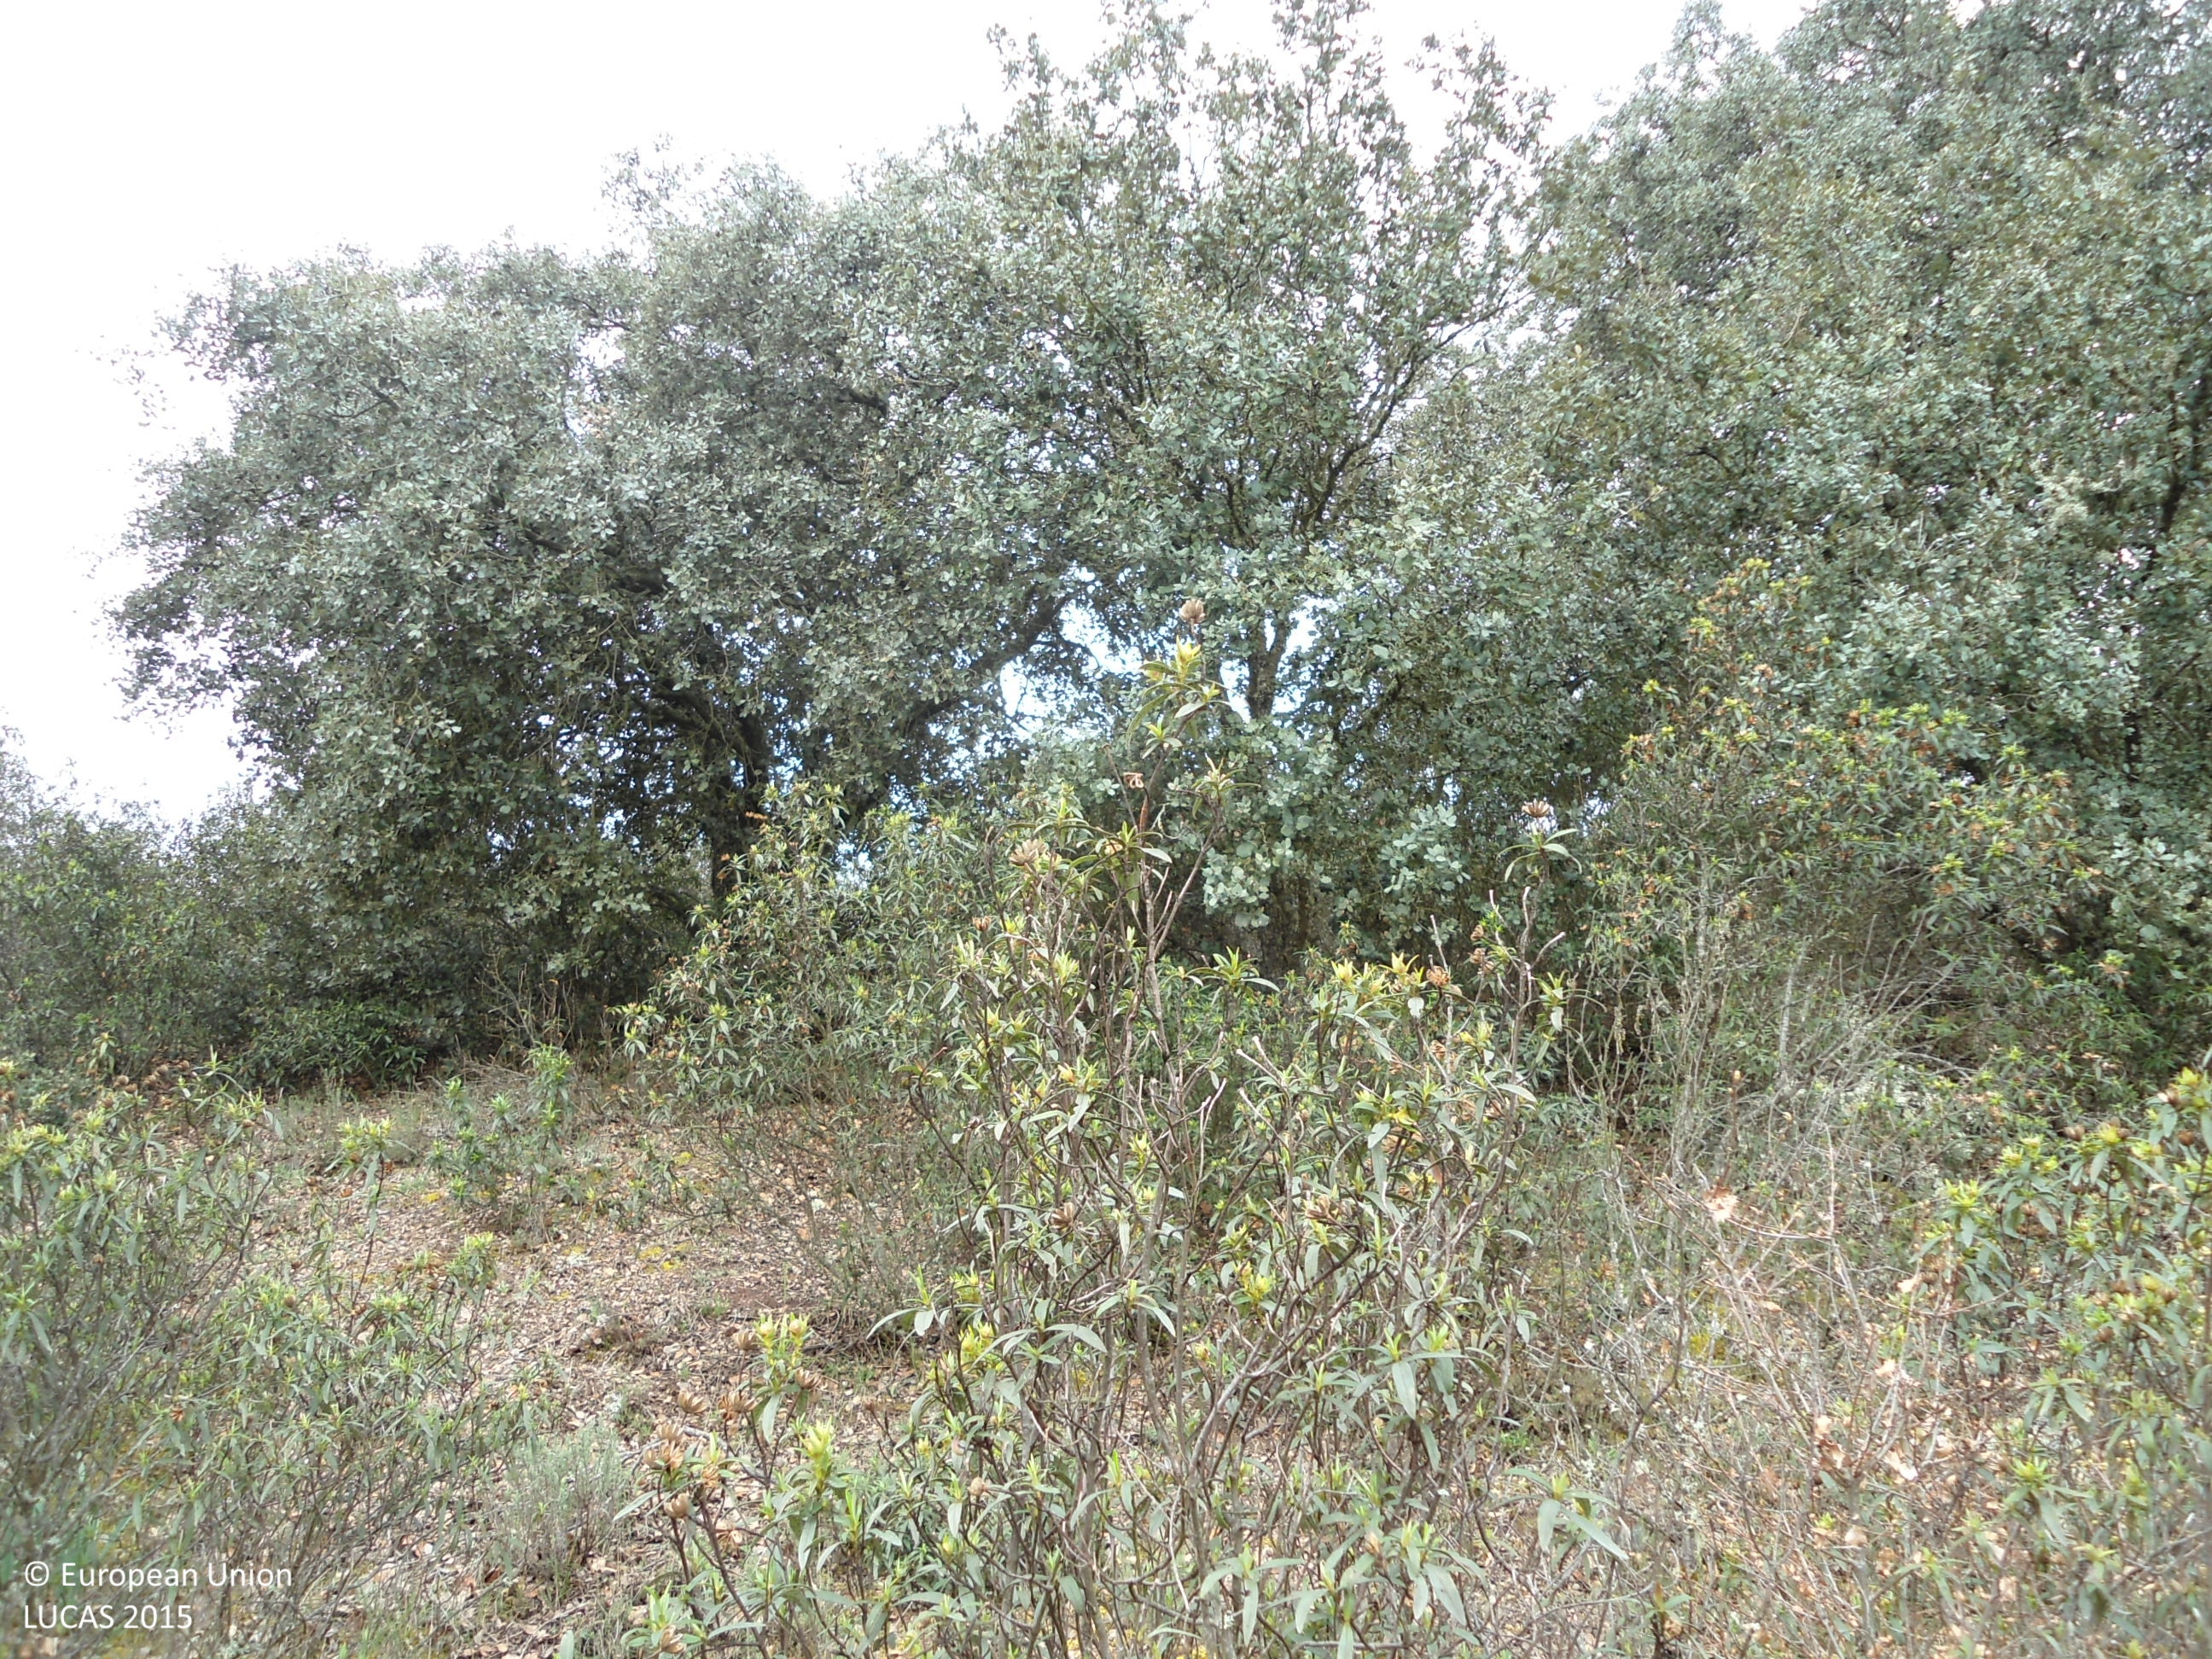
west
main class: Woodland
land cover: Broadleaved woodland
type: acidophilous oak and oak-birch forest
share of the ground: 50 - 75 %
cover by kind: broadleaved forest trees 80 %, shrubs 20 %
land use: Forestry
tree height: < 5 m
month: April
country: ES
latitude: 41.5357
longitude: -5.8997
